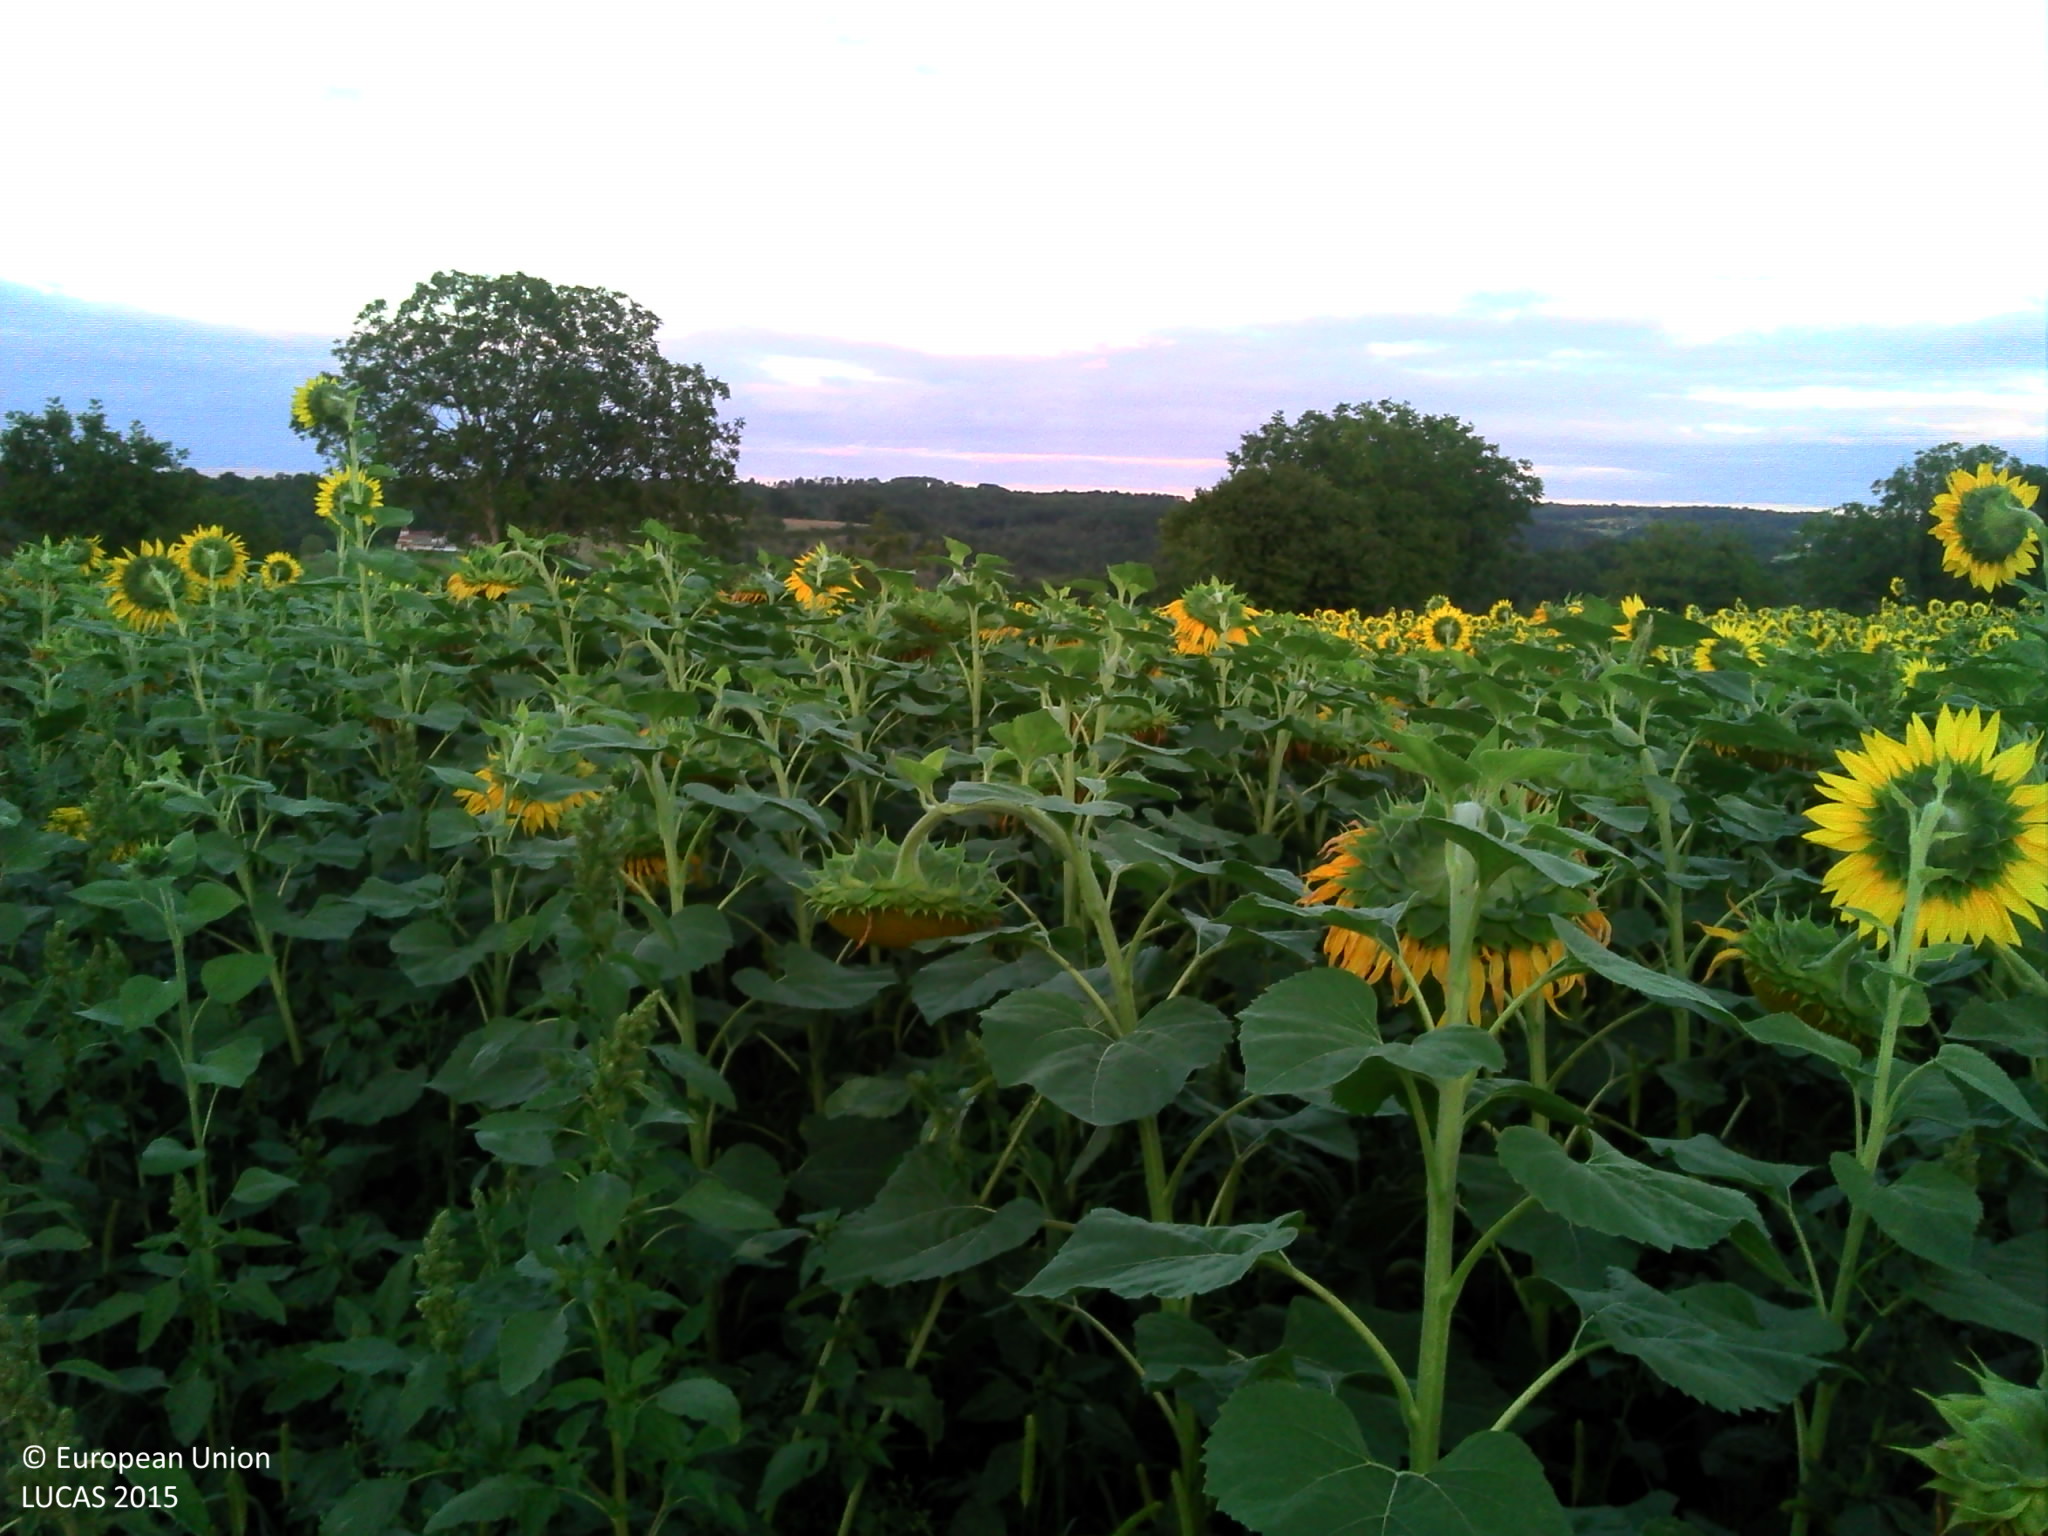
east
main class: Cropland
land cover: Sunflower
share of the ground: > 75 %
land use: Agriculture (excluding fallow land and kitchen gardens)
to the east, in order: Sunflower; Abandoned hedges; Common wheat; Managed hedges; Durum wheat; Broadleaved woodland; Grassland with sparse tree/shrub cover; Electric lines; Paved roads, cycling and walking lanes; Grassland without tree/shrub cover; Abandoned hedges; Maize
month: August
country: FR
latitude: 45.2336
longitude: 0.4474
